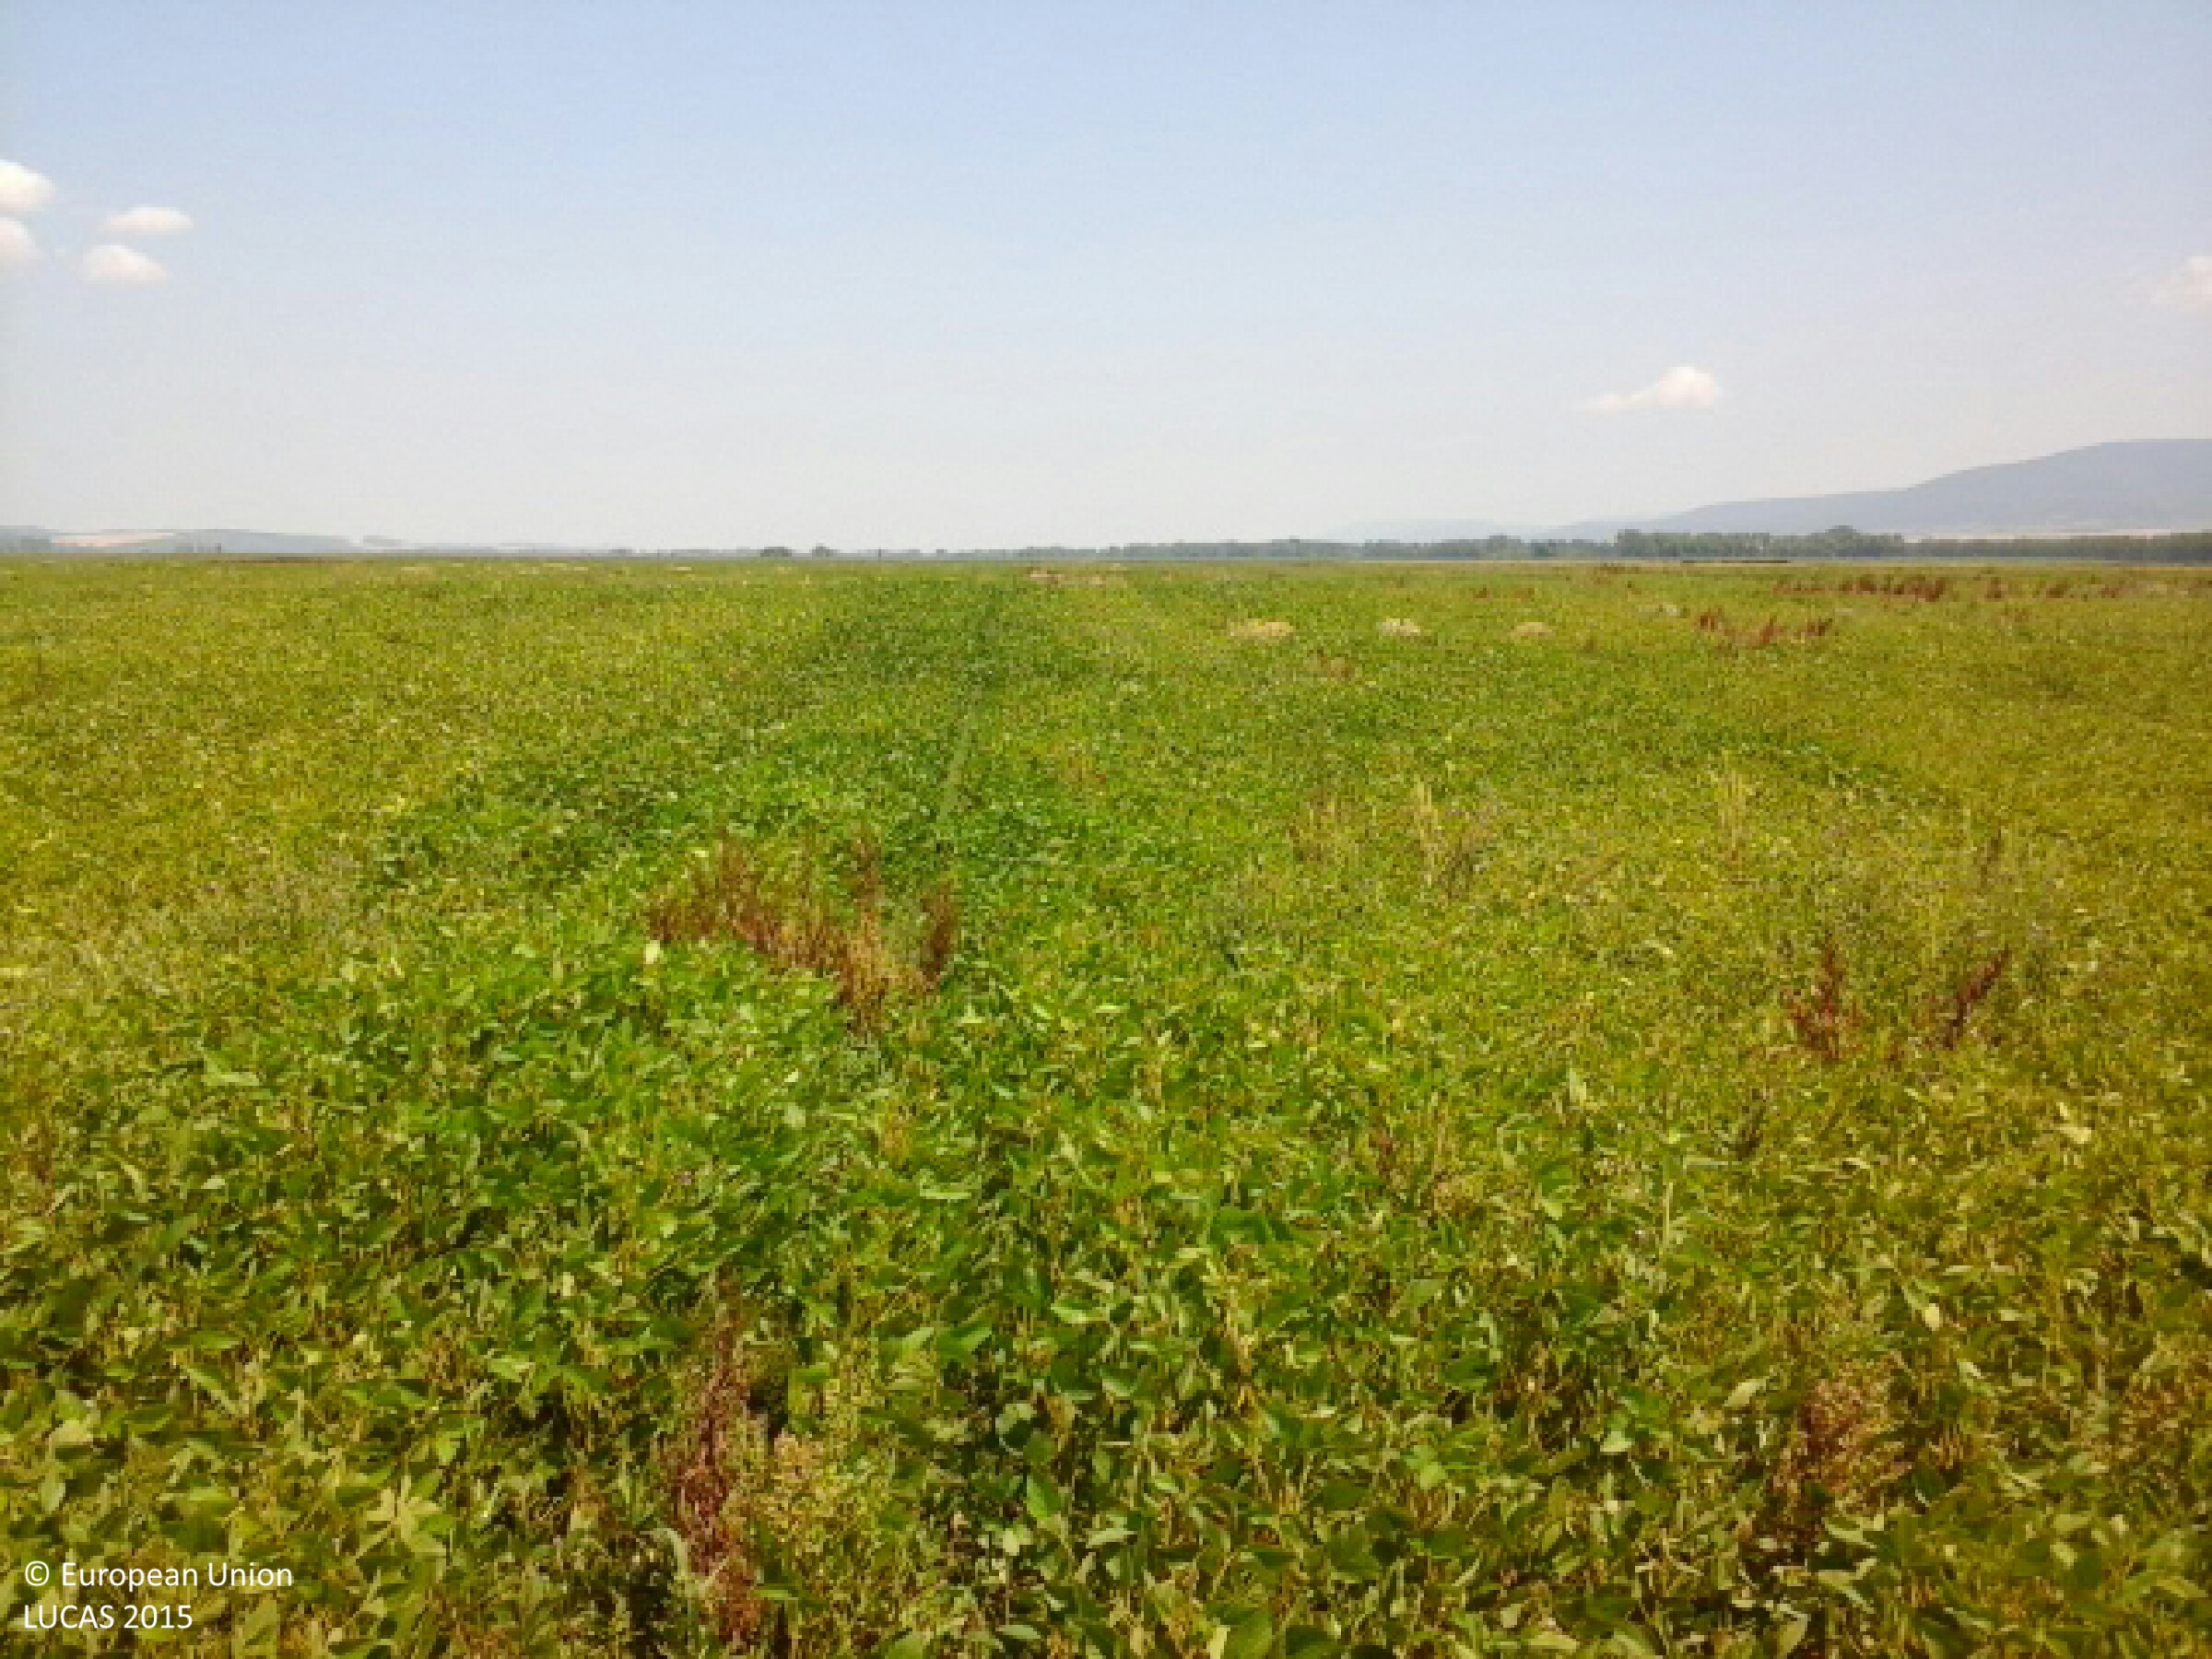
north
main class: Cropland
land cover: Soya
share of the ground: > 75 %
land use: Agriculture (excluding fallow land and kitchen gardens)
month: July
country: HU
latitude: 48.3793
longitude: 21.1814
